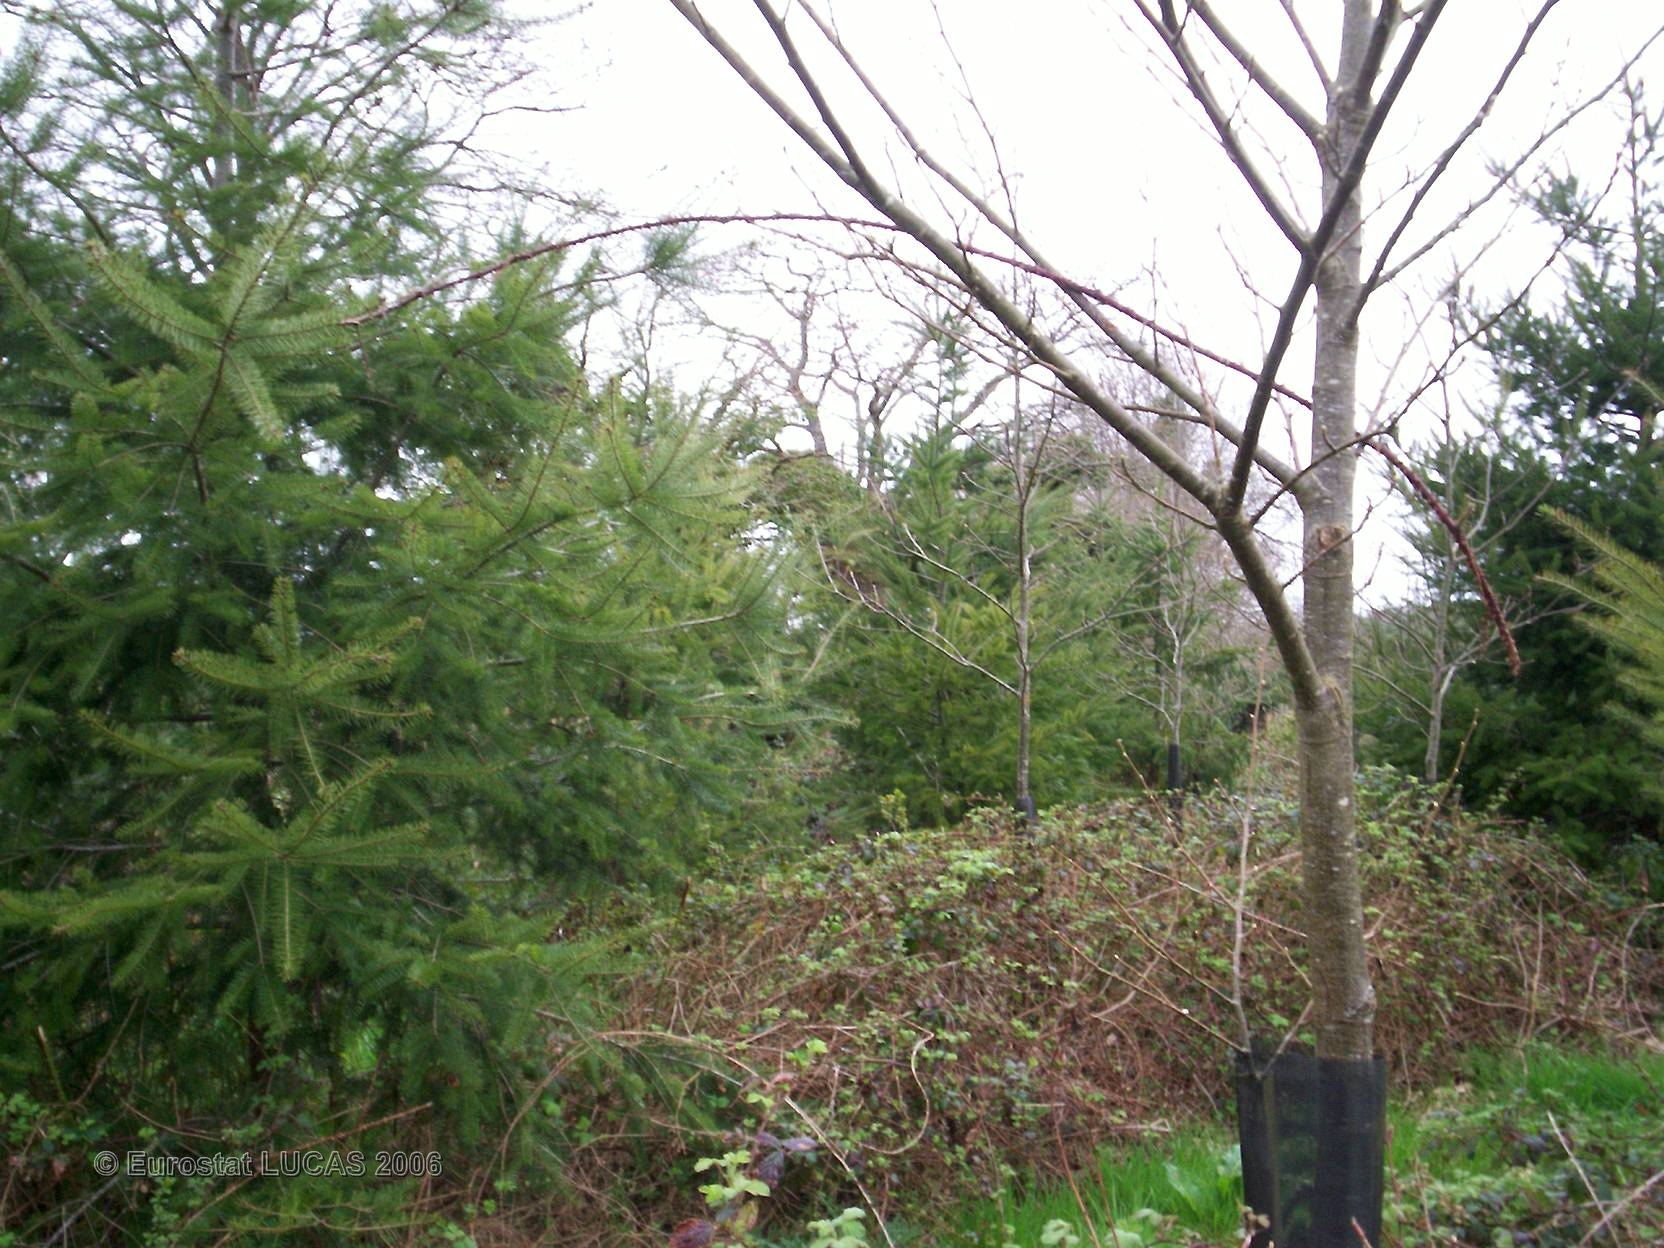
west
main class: Woodland
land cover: Coniferous forest
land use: Forestry
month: April
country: FR
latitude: 47.9961
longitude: -3.6007
